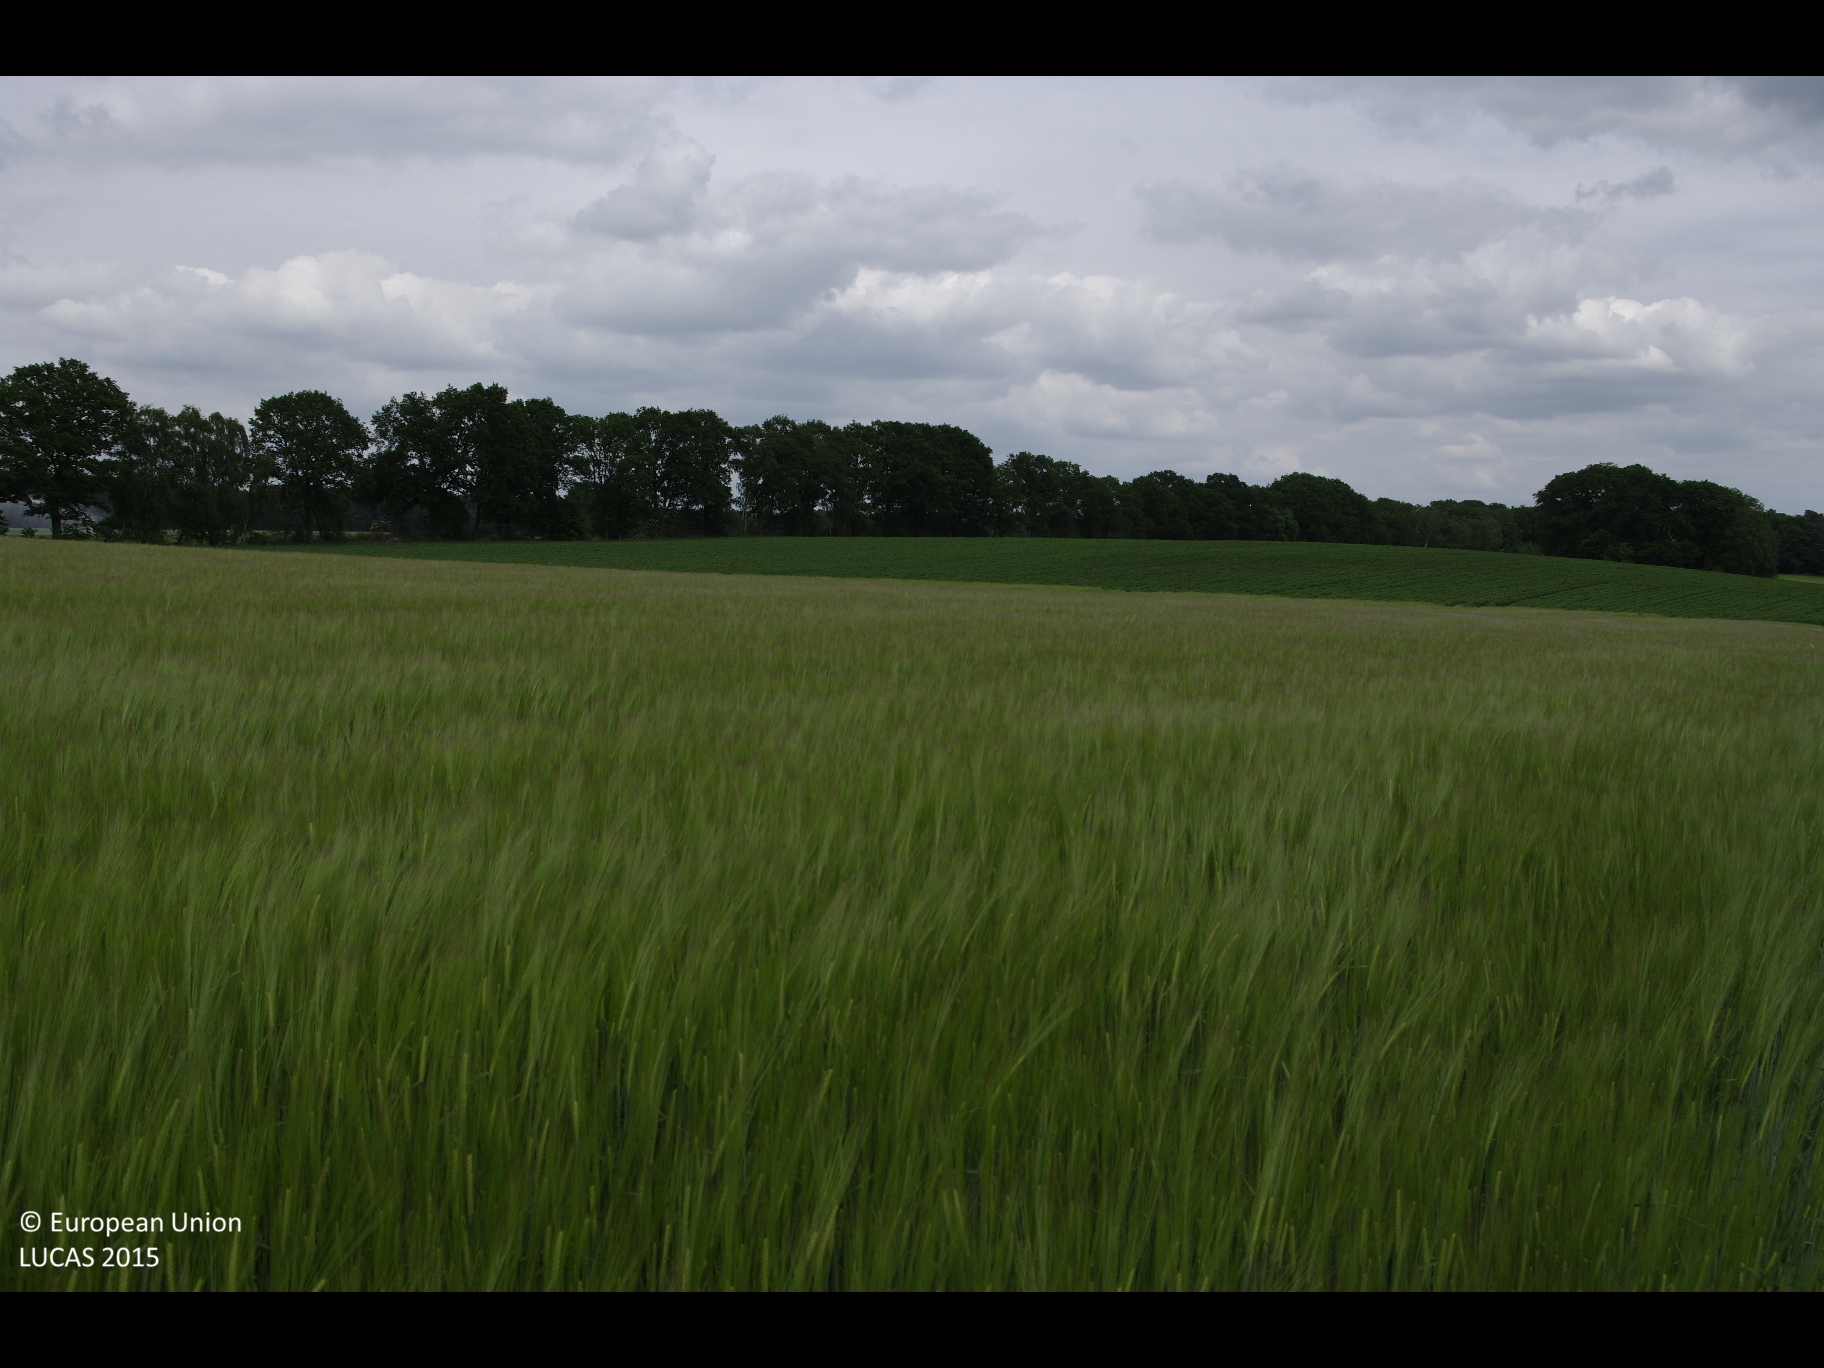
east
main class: Cropland
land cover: Barley
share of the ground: > 75 %
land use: Agriculture (excluding fallow land and kitchen gardens)
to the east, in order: Barley; Potatoes; Abandoned hedges; Potatoes
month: June
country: DE
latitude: 53.1140
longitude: 10.3136
